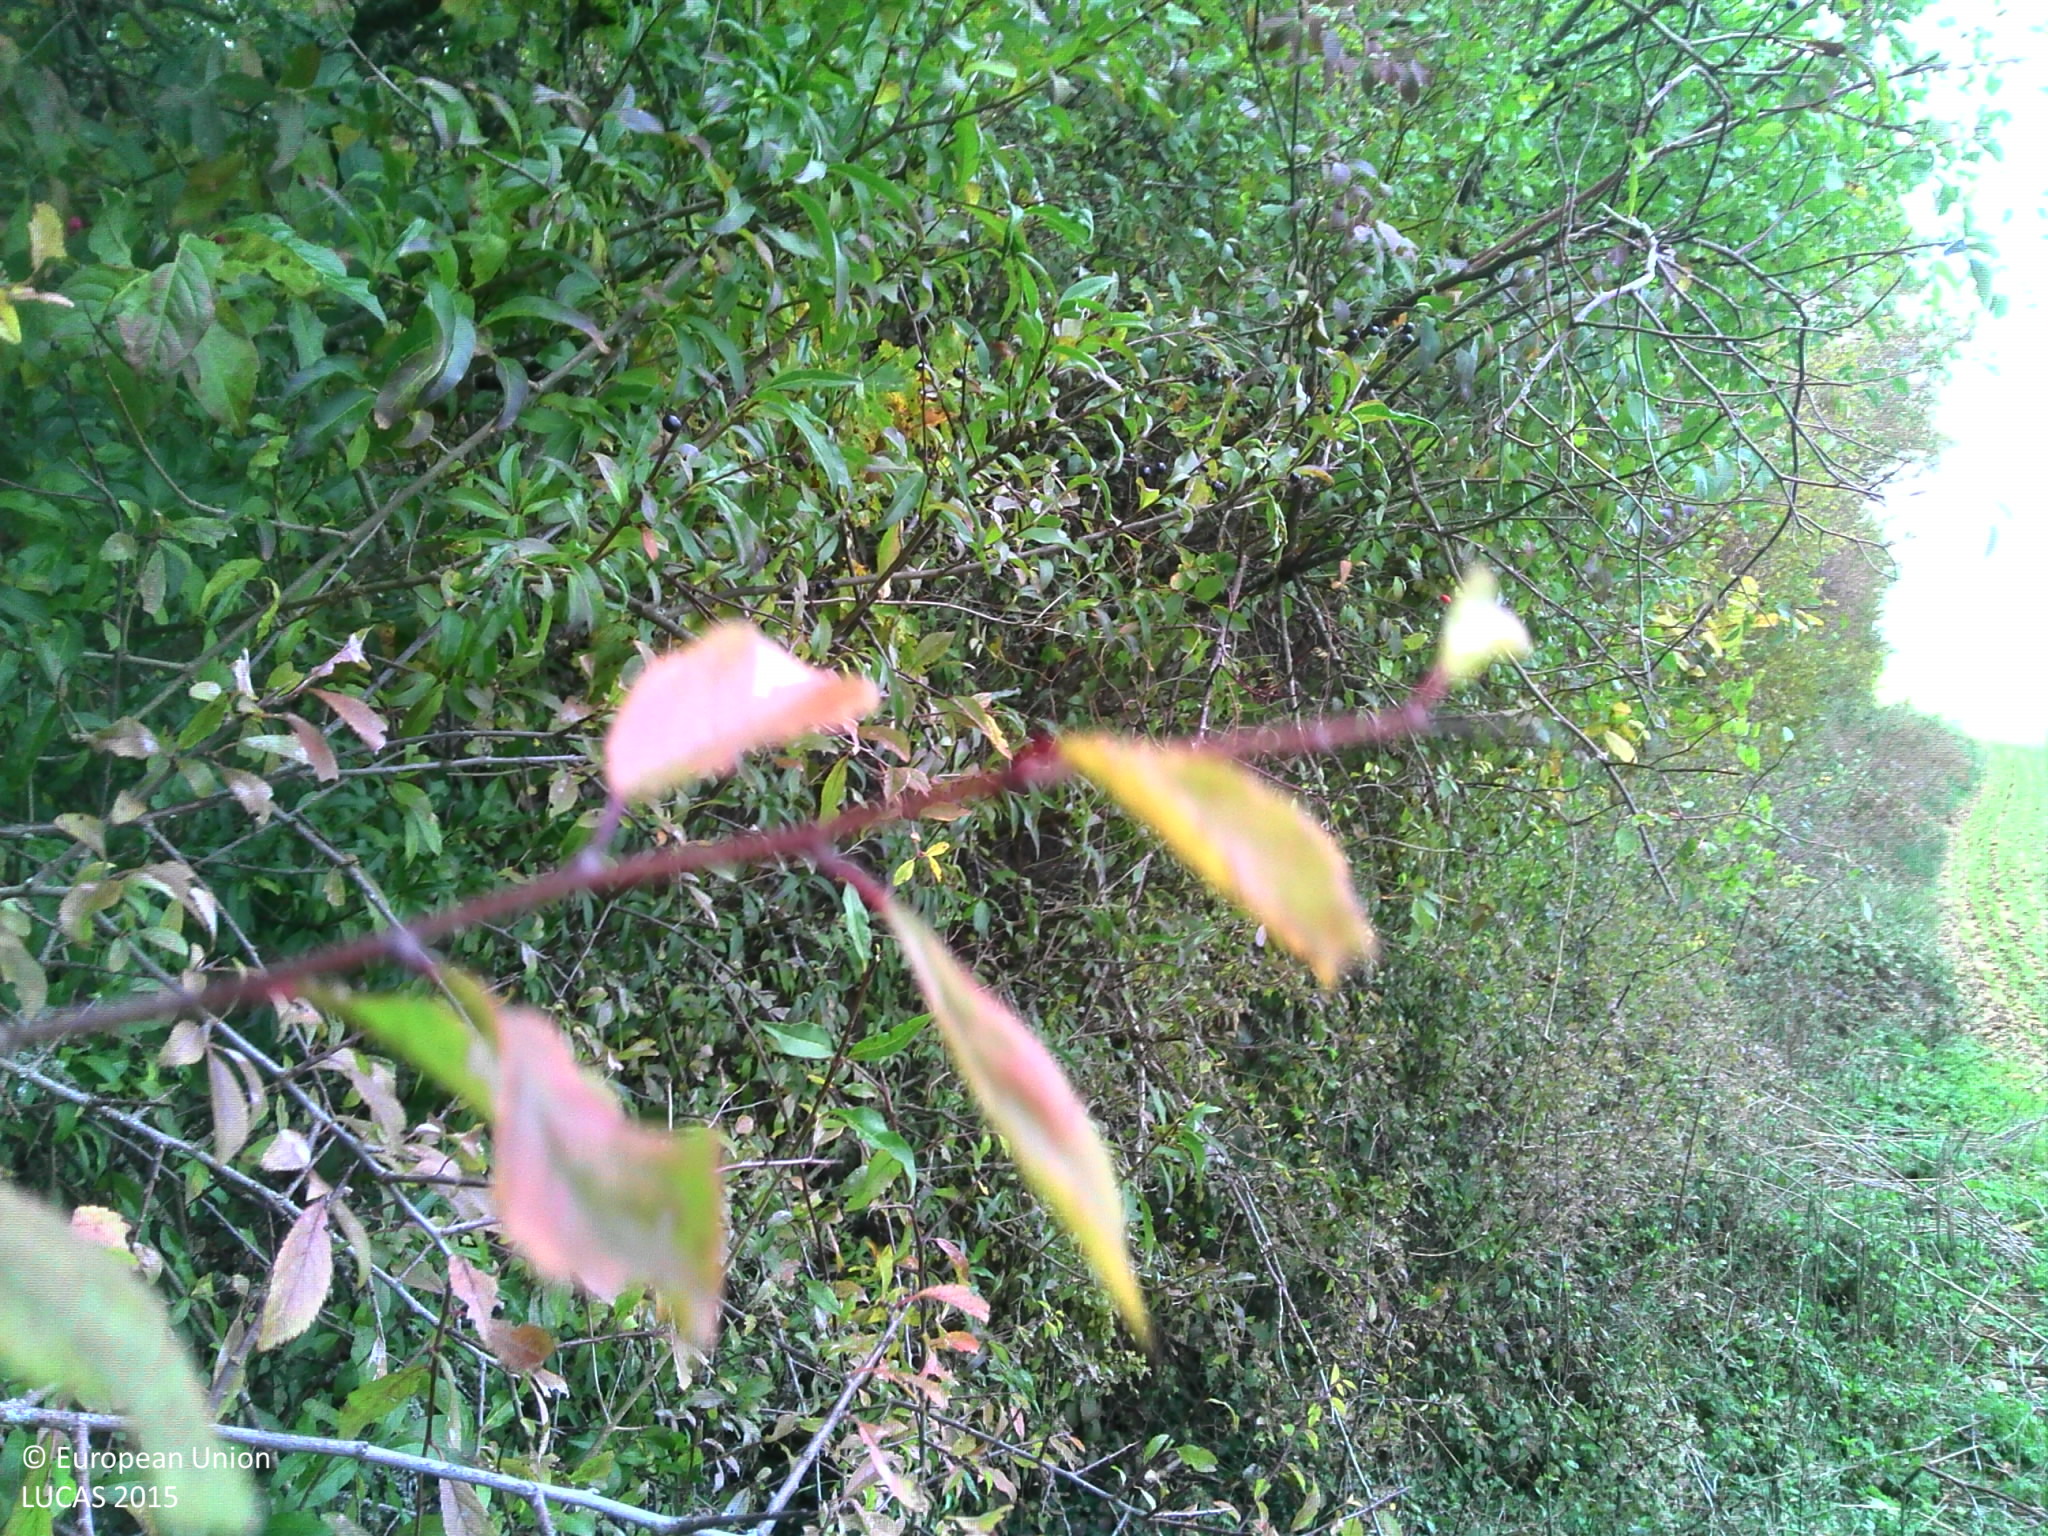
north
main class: Woodland
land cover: Broadleaved woodland
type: mesophytic deciduous forest
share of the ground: > 75 %
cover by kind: broadleaved forest trees 100 %
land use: Semi-natural and natural areas not in use
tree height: > 5 m
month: October
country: FR
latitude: 47.4585
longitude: 4.9462
